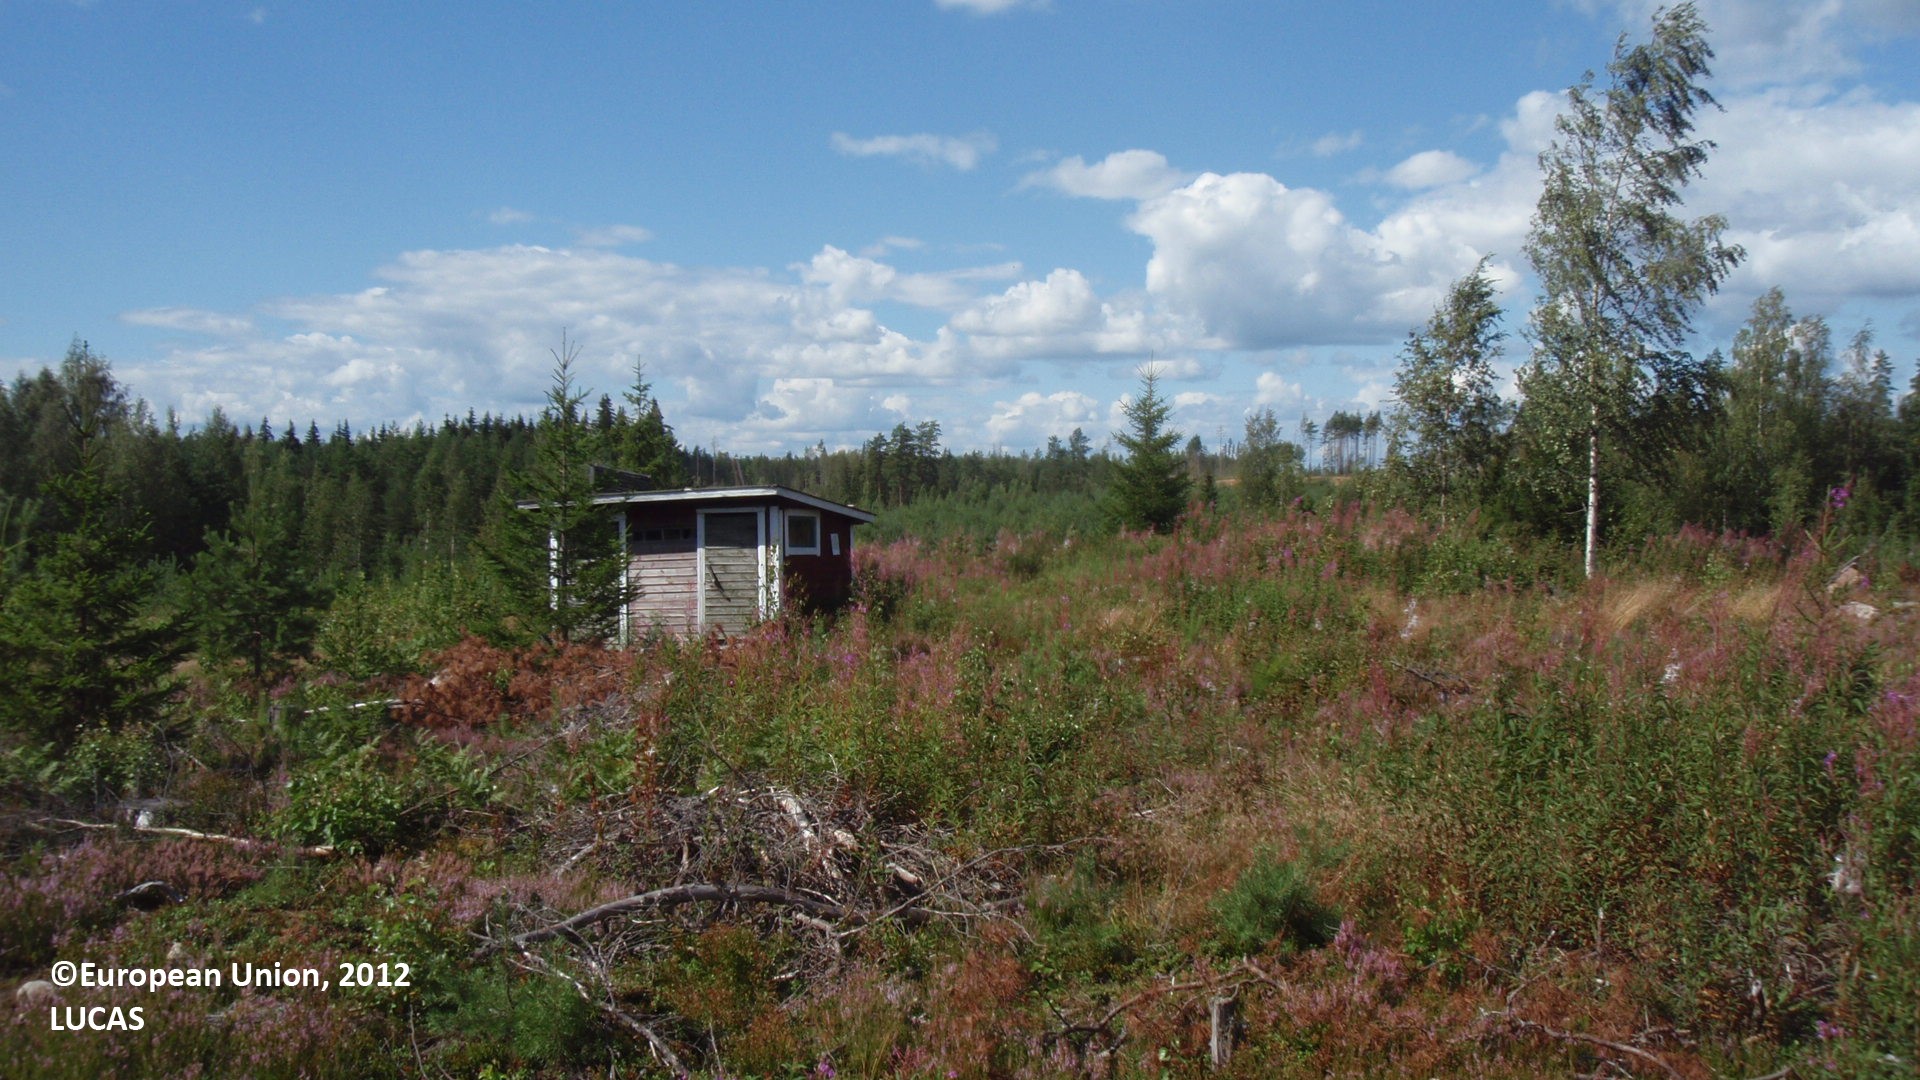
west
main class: Shrubland
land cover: Shrubland with sparse tree cover
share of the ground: 50 - 75 %
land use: Forestry
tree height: < 5 m
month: August
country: FI
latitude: 61.0492
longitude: 27.8422
